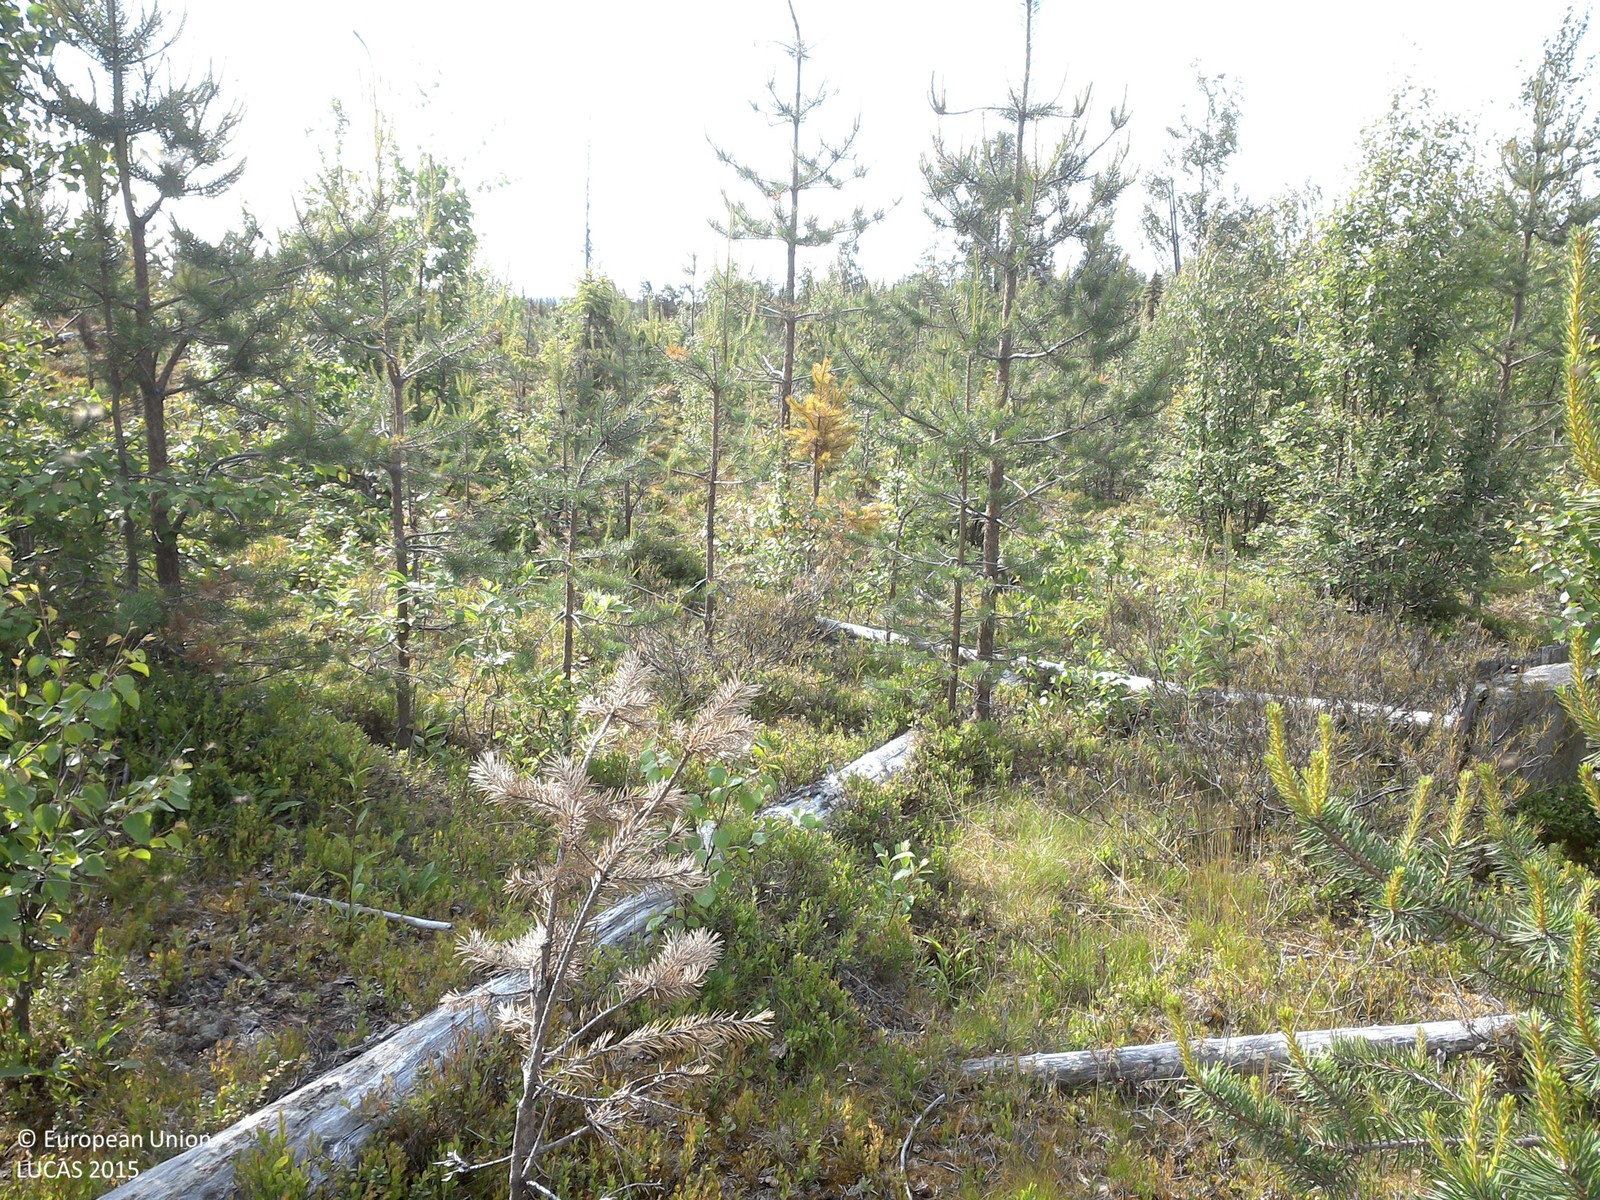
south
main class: Woodland
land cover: Pine dominated mixed woodland
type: boreal forest
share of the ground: 10 - 25 %
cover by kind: shrubs 65 %, coniferous forest trees 15 %, unconsolidated bare surface 10 %, broadleaved forest trees 5 %, lichens and mosses 5 %
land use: Forestry
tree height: < 5 m
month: July
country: SE
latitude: 67.1942
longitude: 23.1707
